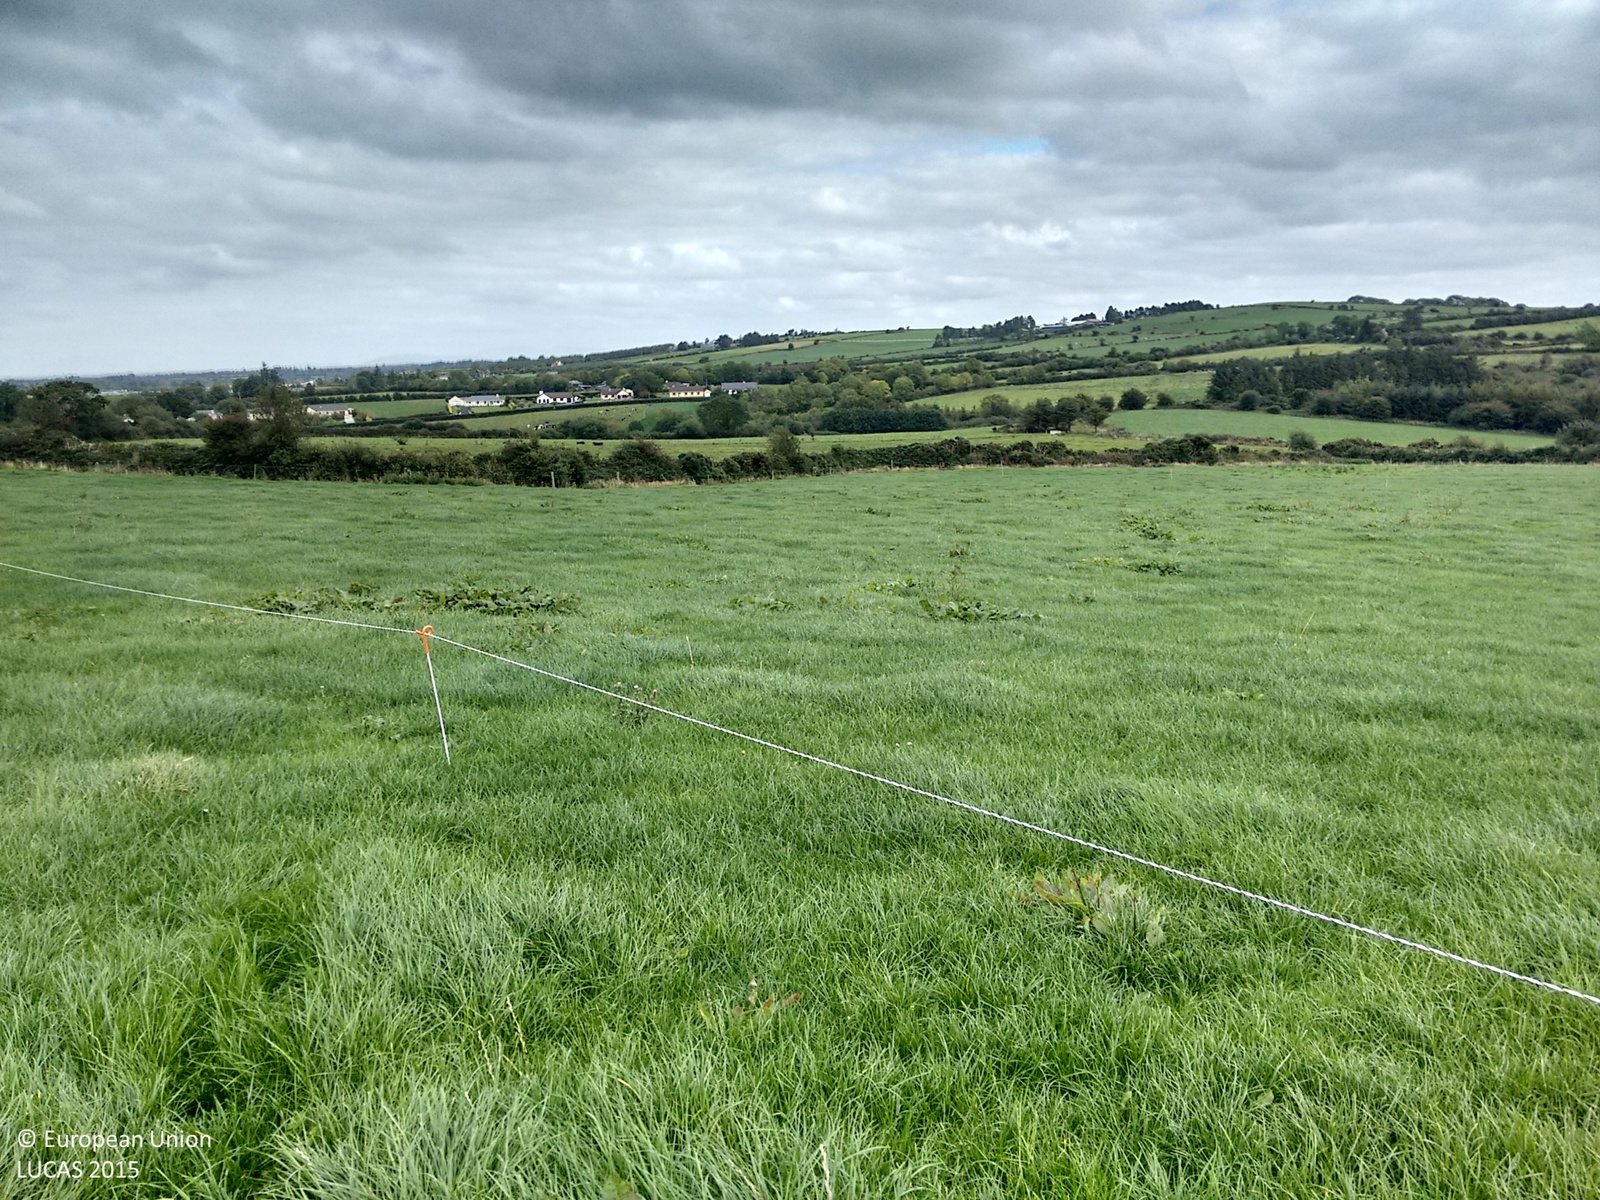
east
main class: Grassland
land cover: Grassland without tree/shrub cover
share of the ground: > 75 %
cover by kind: herbaceous plants 100 %
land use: Agriculture (excluding fallow land and kitchen gardens)
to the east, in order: Grassland without tree/shrub cover; Fences; Grassland without tree/shrub cover; Fences; Ditches and canals; Abandoned hedges; Grassland without tree/shrub cover; Fences; Tracks; Fences; Grassland without tree/shrub cover
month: September
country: IE
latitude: 52.3332
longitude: -8.9209
